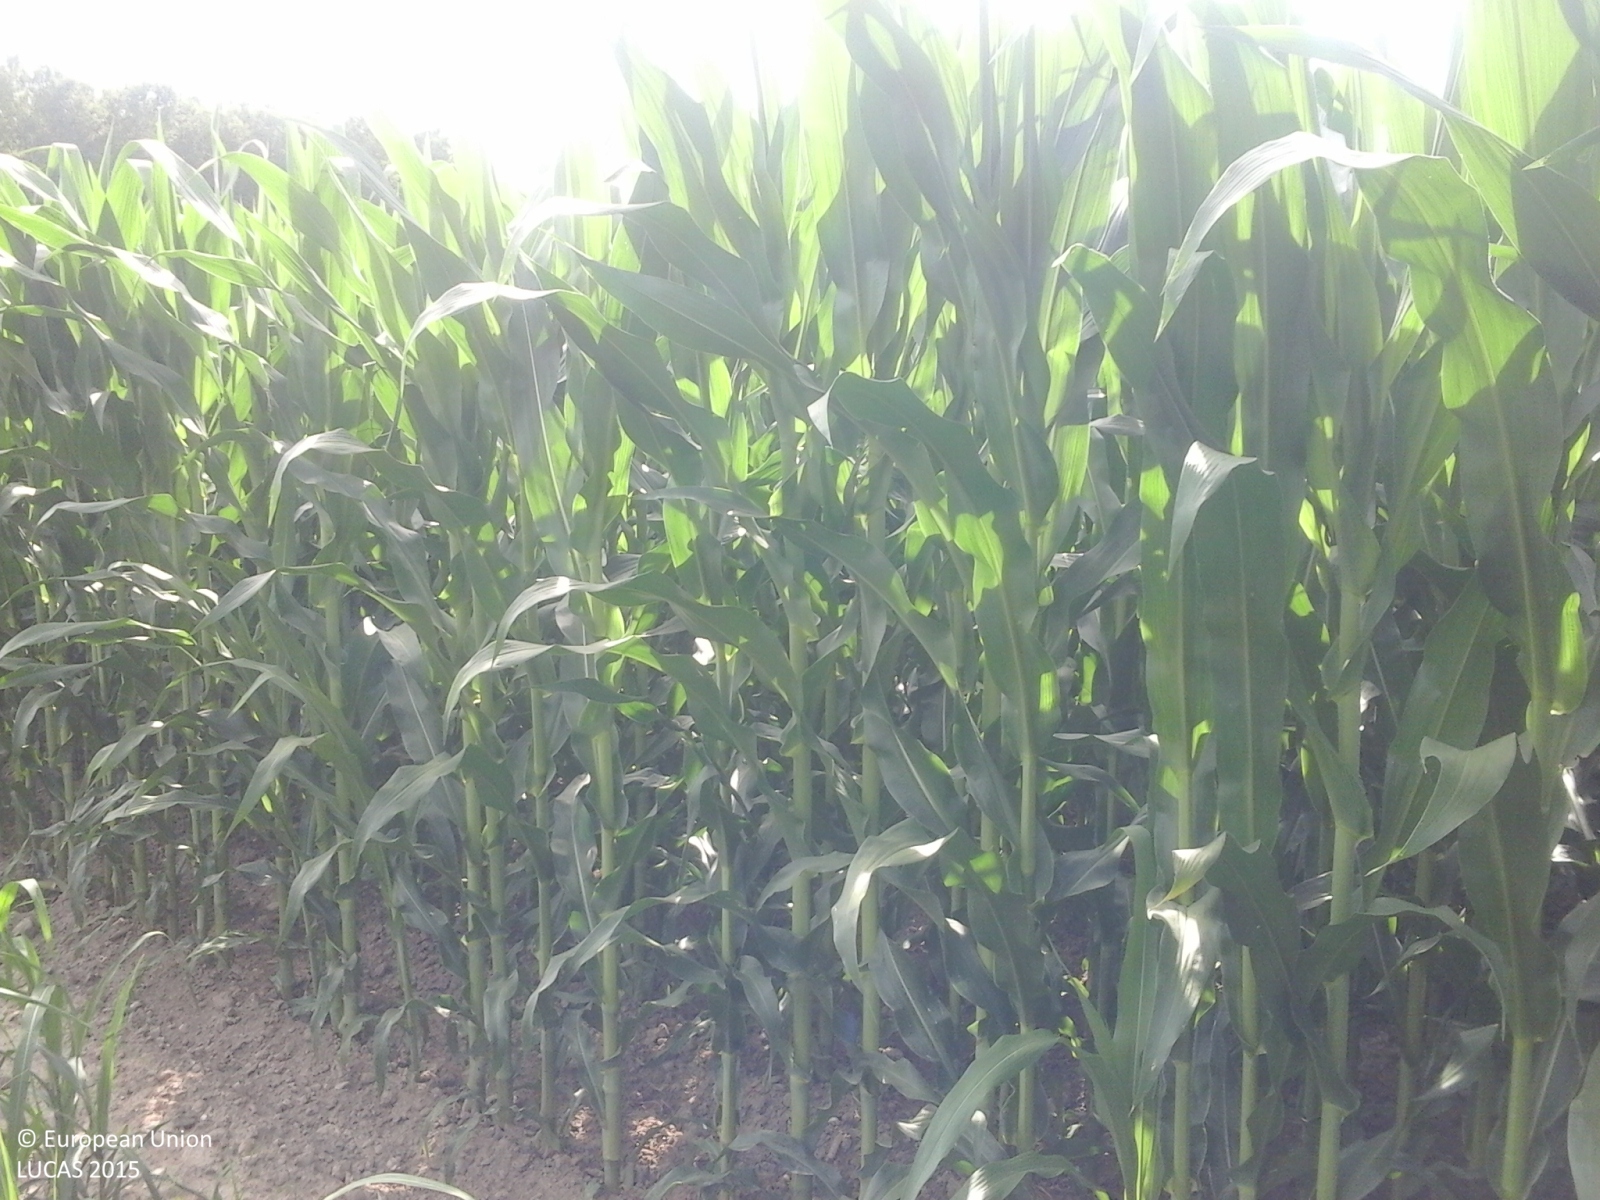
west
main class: Cropland
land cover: Maize
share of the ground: > 75 %
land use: Agriculture (excluding fallow land and kitchen gardens)
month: June
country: IT
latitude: 45.0289
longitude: 8.7965
